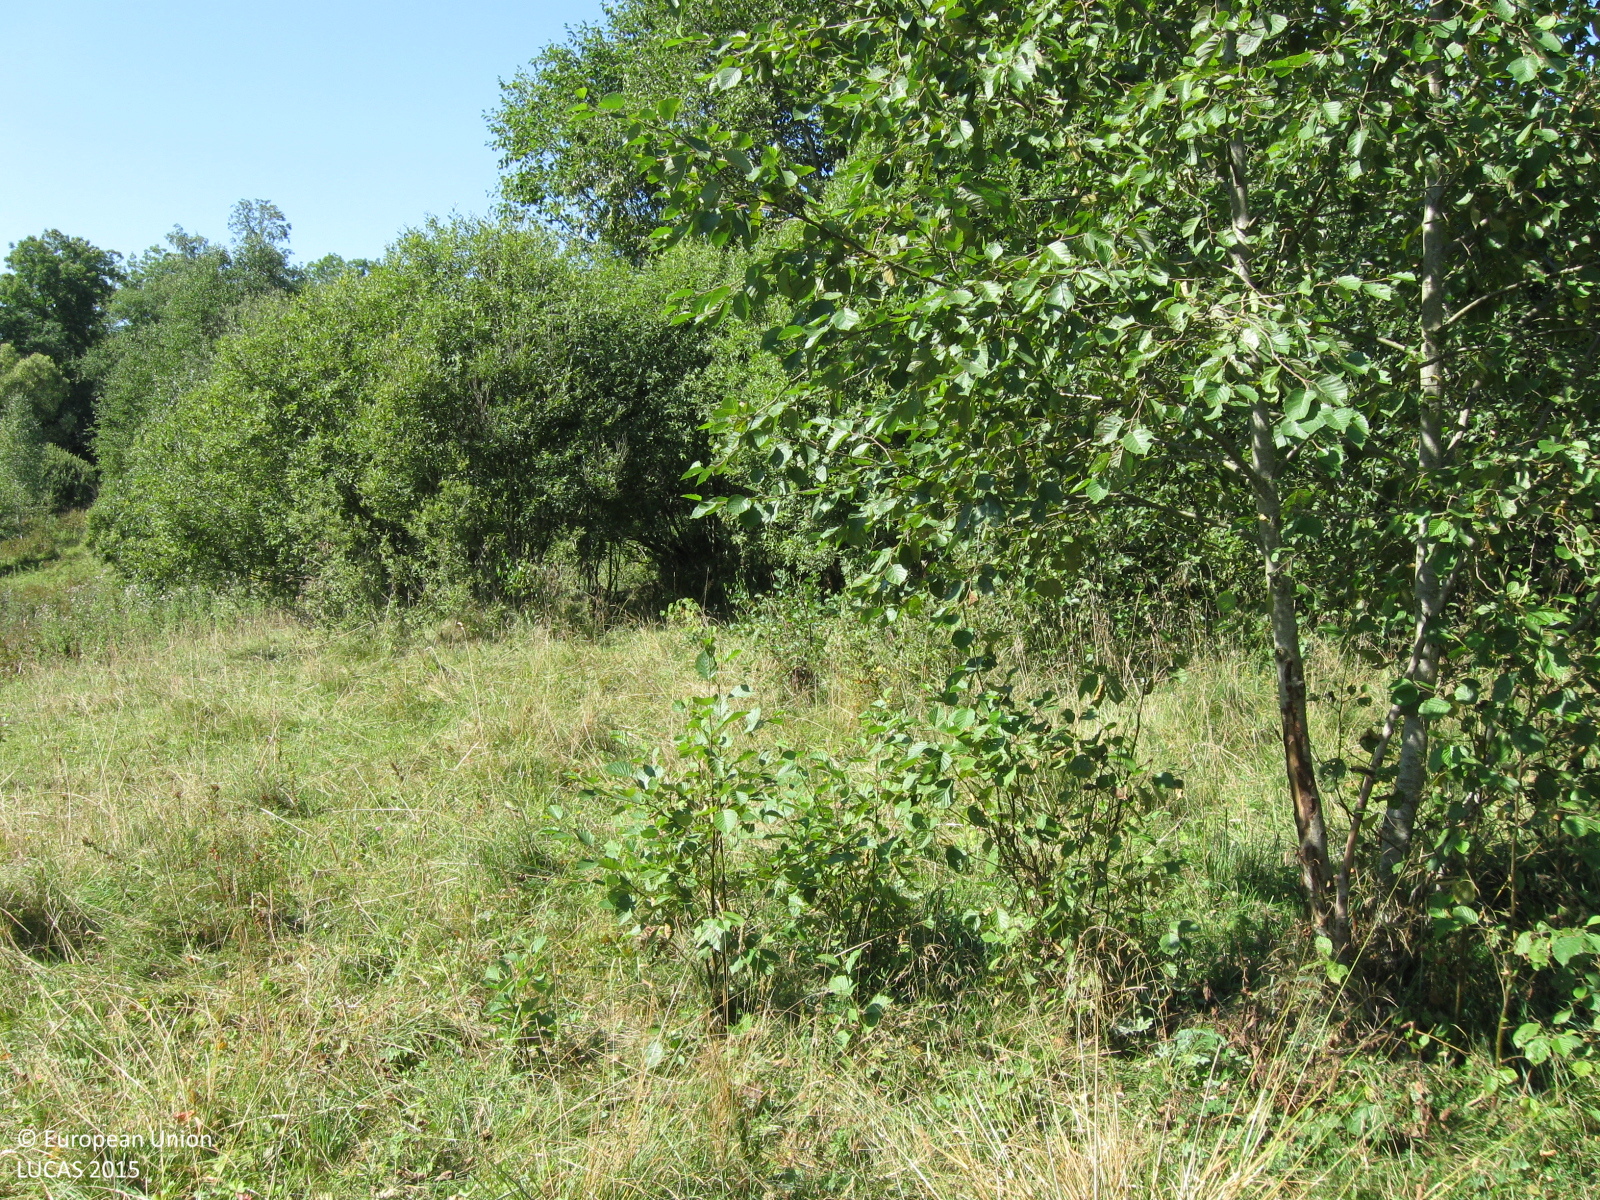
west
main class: Woodland
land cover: Broadleaved woodland
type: non-riverine alder, birch or aspen forest
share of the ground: 25 - 50 %
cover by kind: herbaceous plants 60 %, broadleaved forest trees 30 %, shrubs 10 %
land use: Forestry
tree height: < 5 m
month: August
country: LT
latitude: 55.3865
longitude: 22.5483
